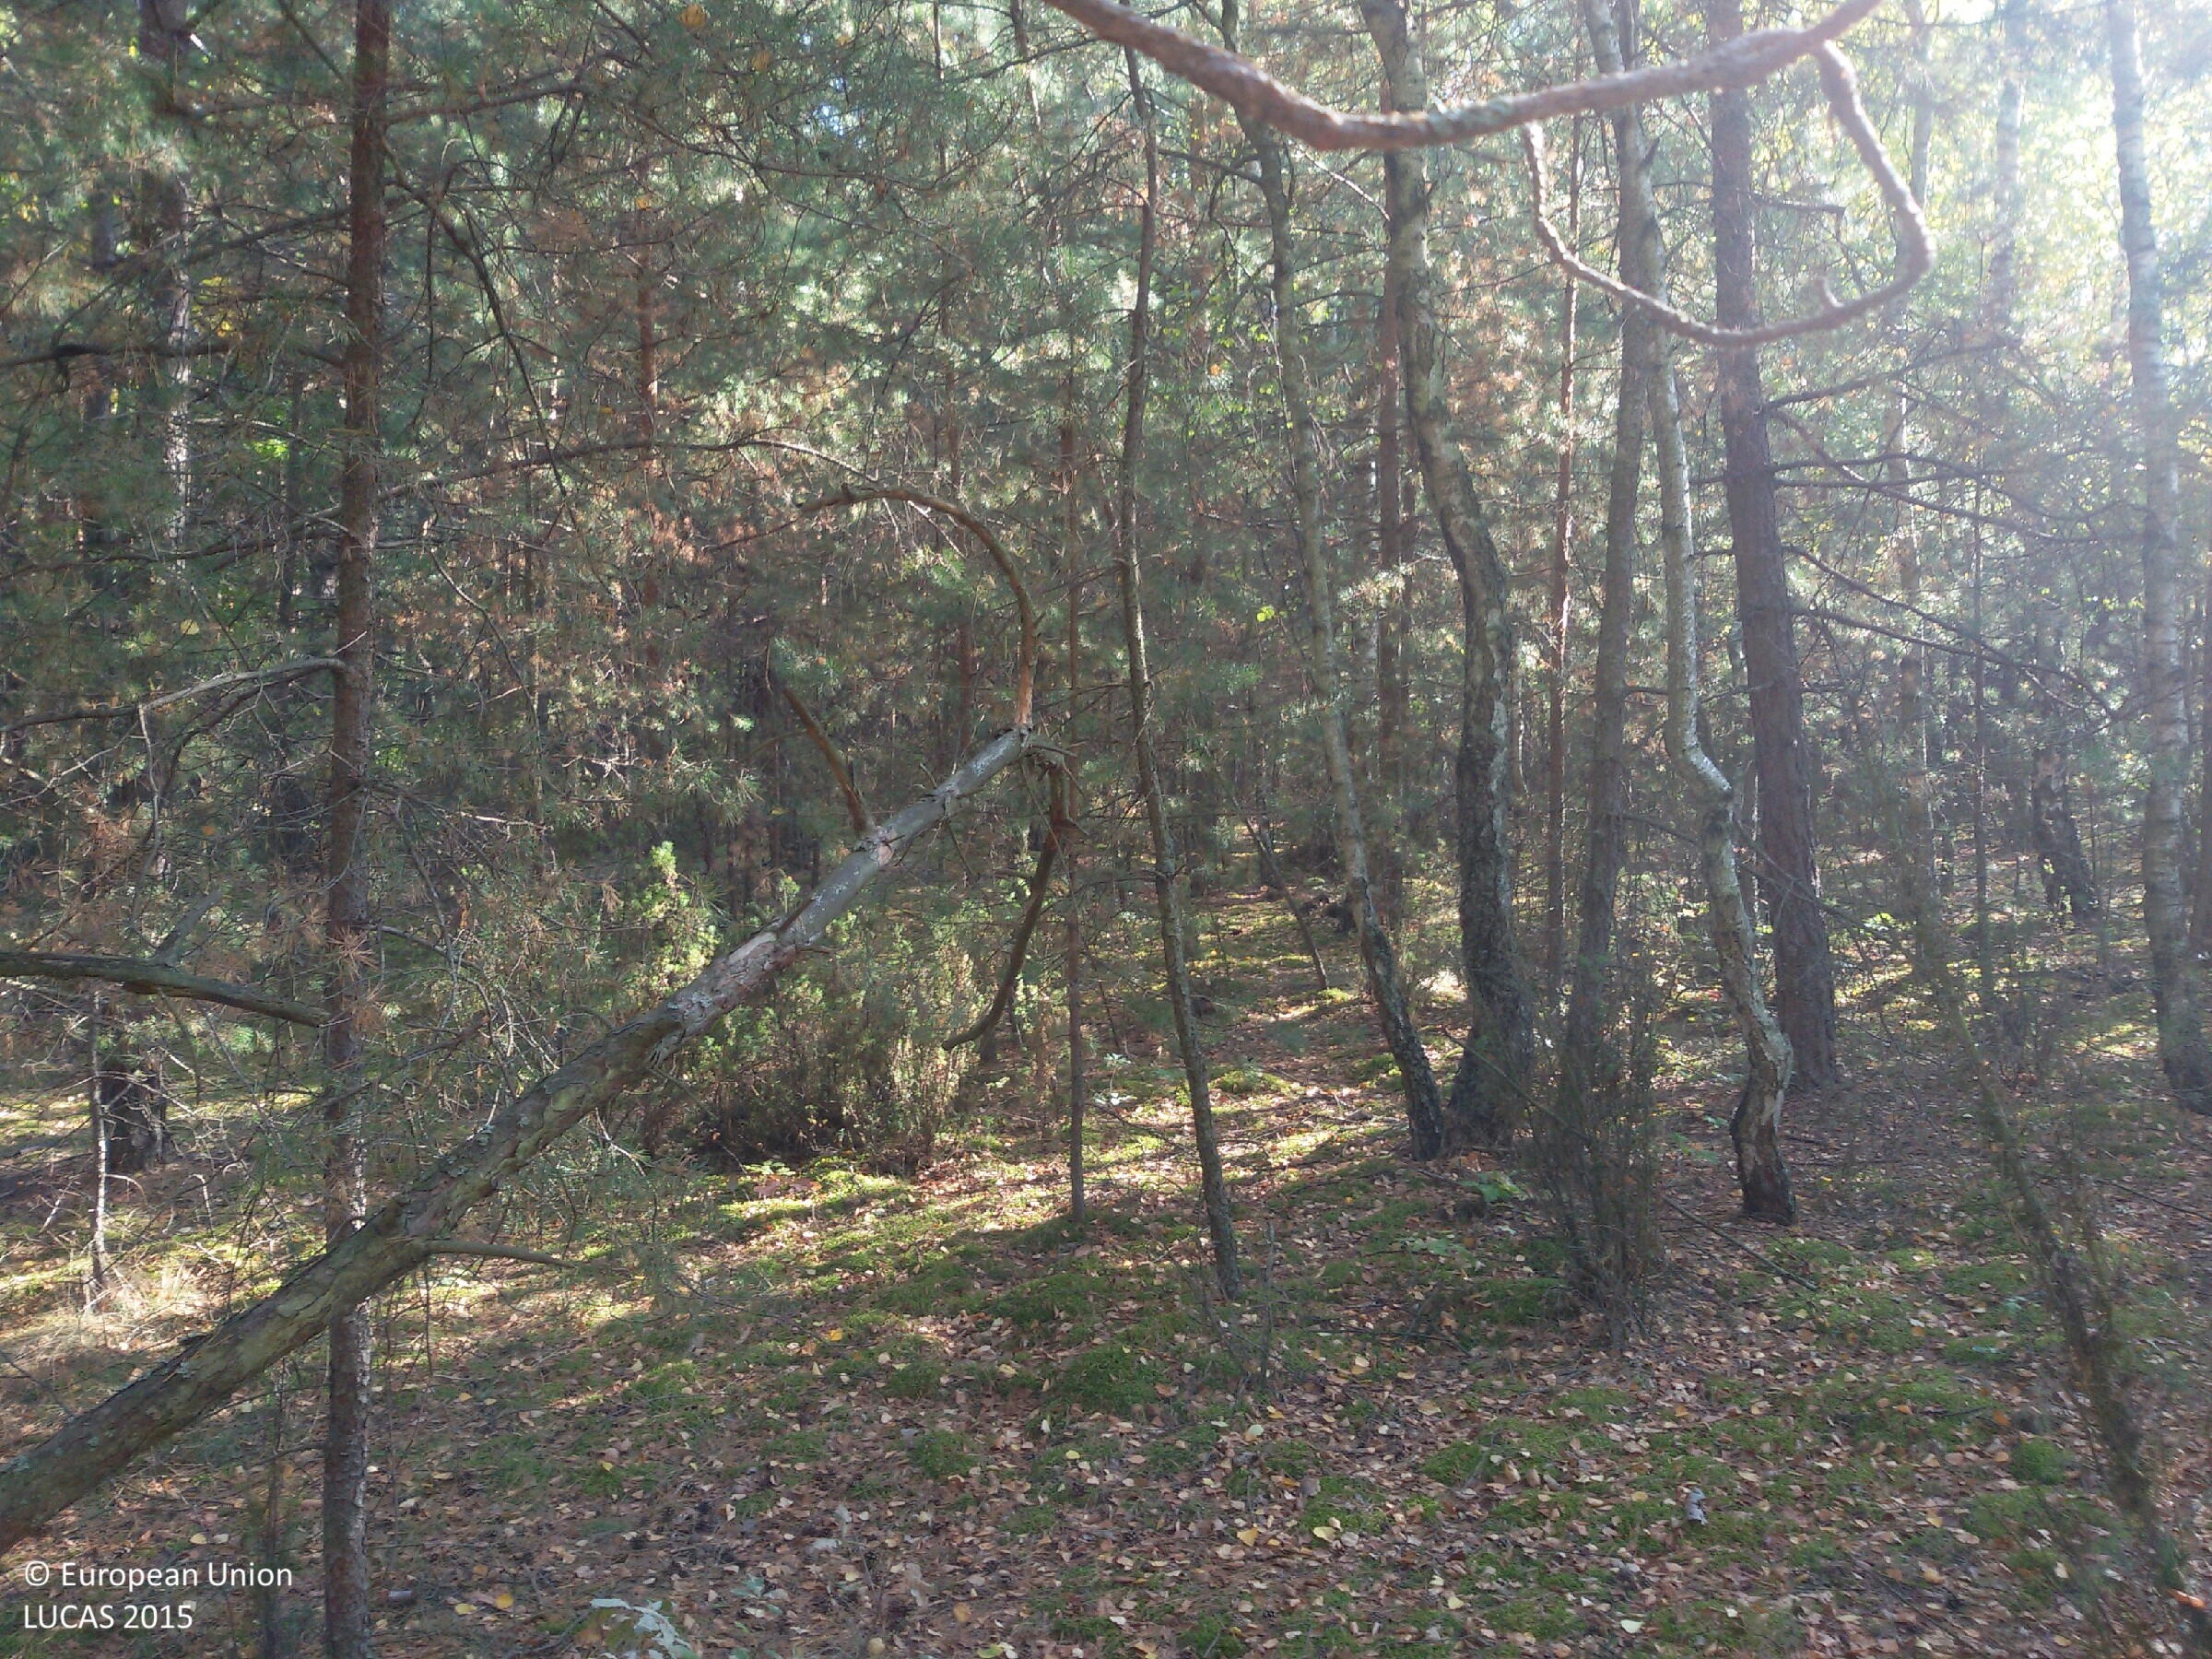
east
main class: Woodland
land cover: Pine dominated mixed woodland
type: hemiboreal forest and nemoral coniferous forest and mixed broadleaved-coniferous forest
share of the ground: > 75 %
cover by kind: coniferous forest trees 65 %, broadleaved forest trees 25 %, herbaceous plants 10 %
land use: Forestry
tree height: > 5 m
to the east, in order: Pine dominated mixed woodland; Tracks; Pine dominated mixed woodland
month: October
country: PL
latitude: 51.1125
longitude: 19.6714
